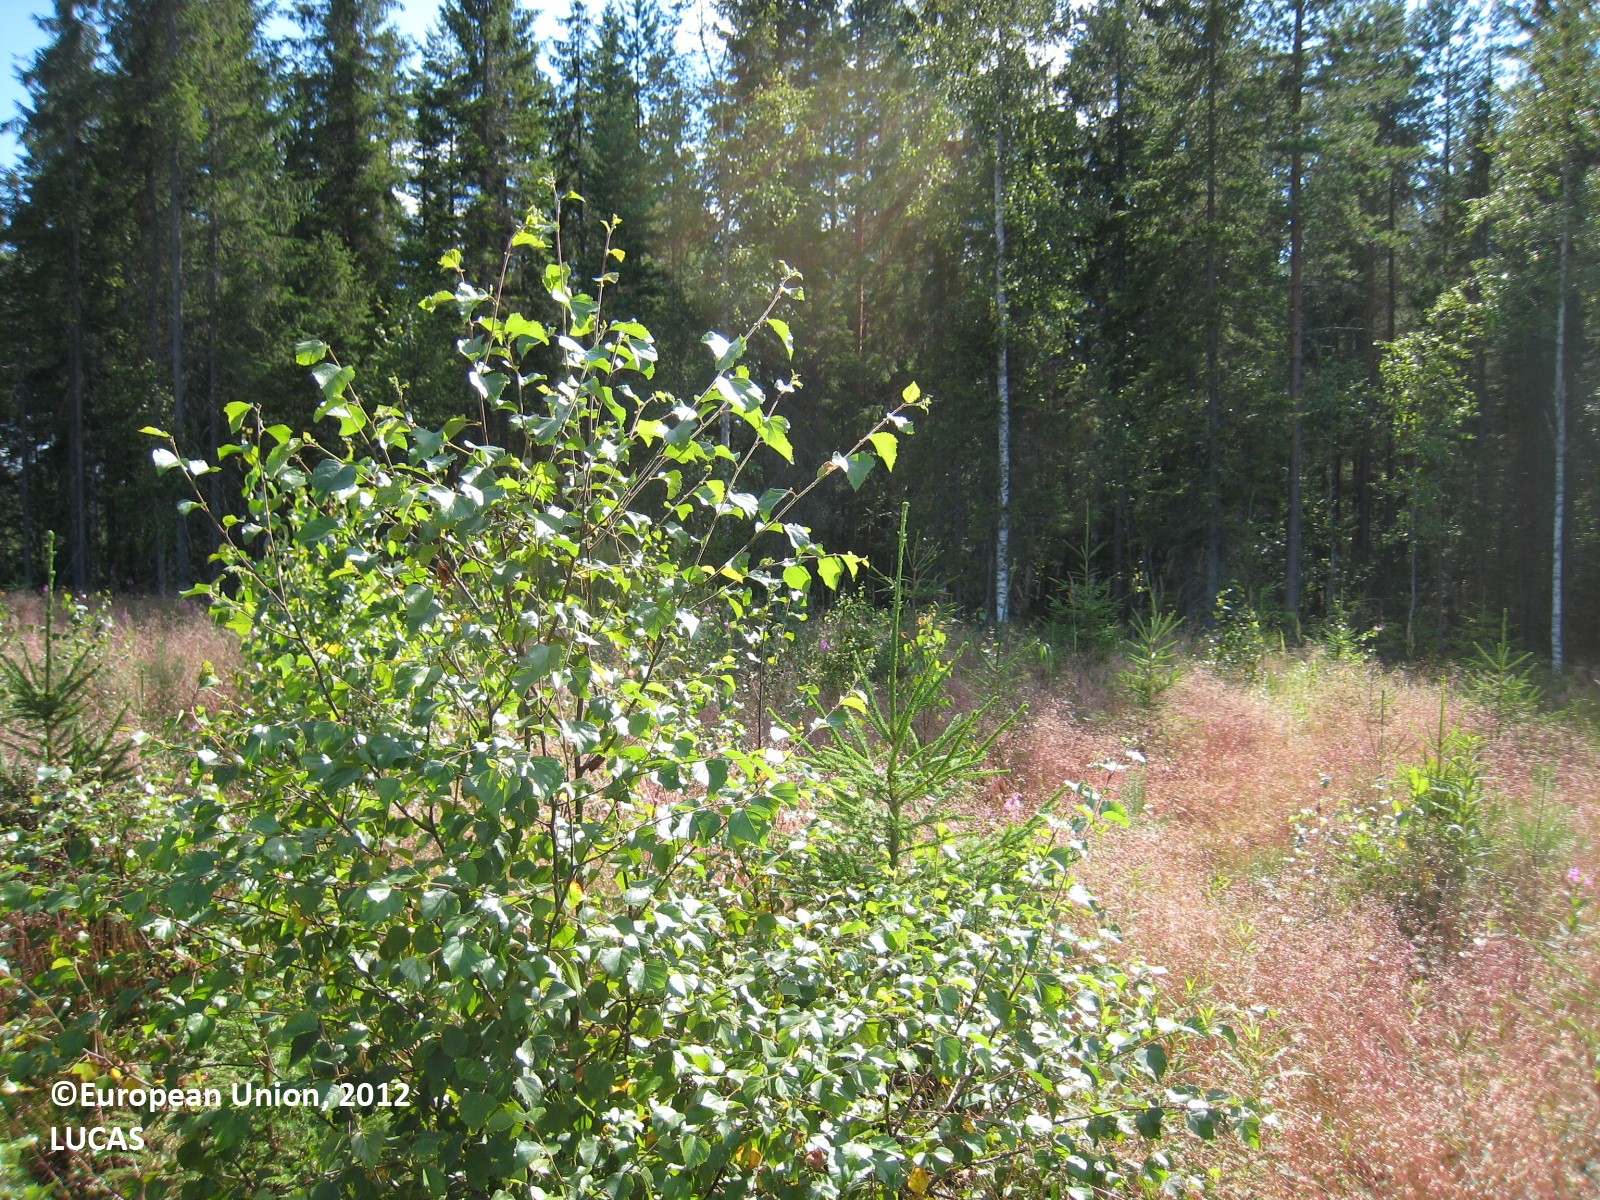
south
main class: Woodland
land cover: Other mixed woodland
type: boreal forest
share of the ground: 25 - 50 %
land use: Forestry
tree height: < 5 m
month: July
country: FI
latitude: 62.6937
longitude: 27.2947
